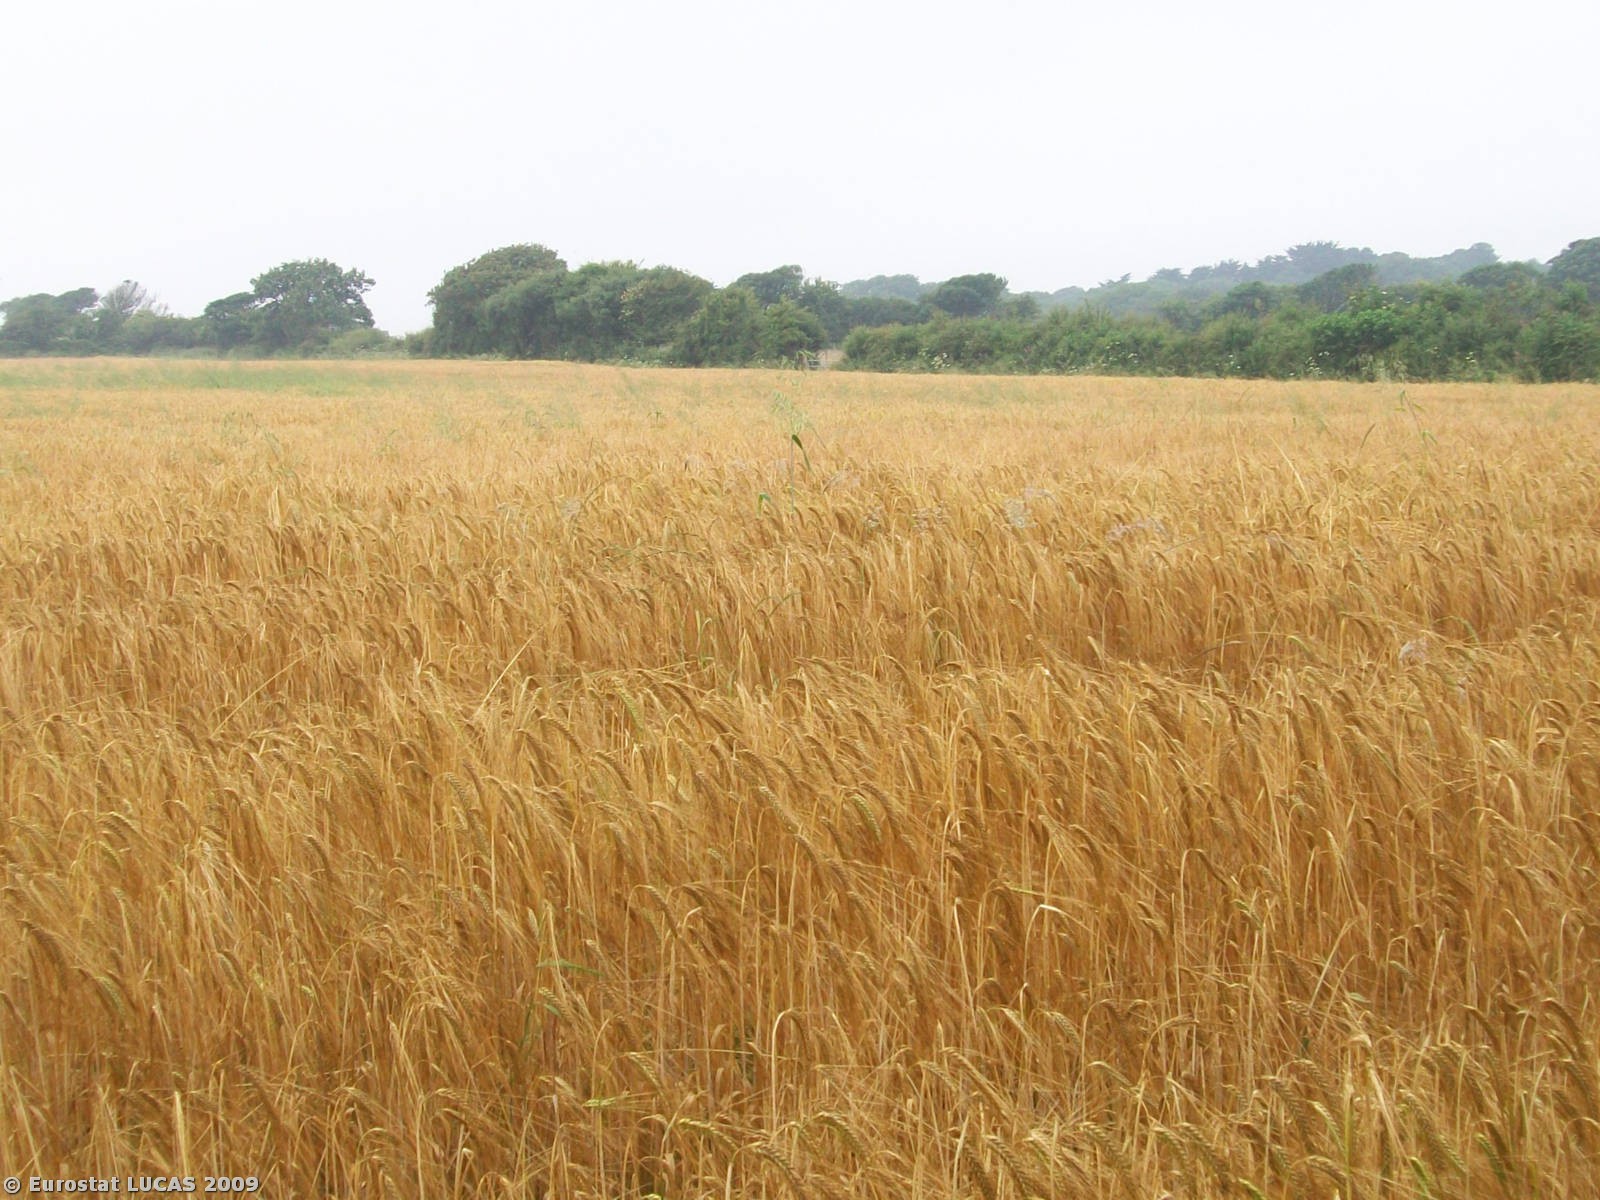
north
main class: Cropland
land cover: Barley
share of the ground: > 75 %
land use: Agriculture (excluding fallow land and kitchen gardens)
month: July
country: GB
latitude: 50.2880
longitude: -5.0936
